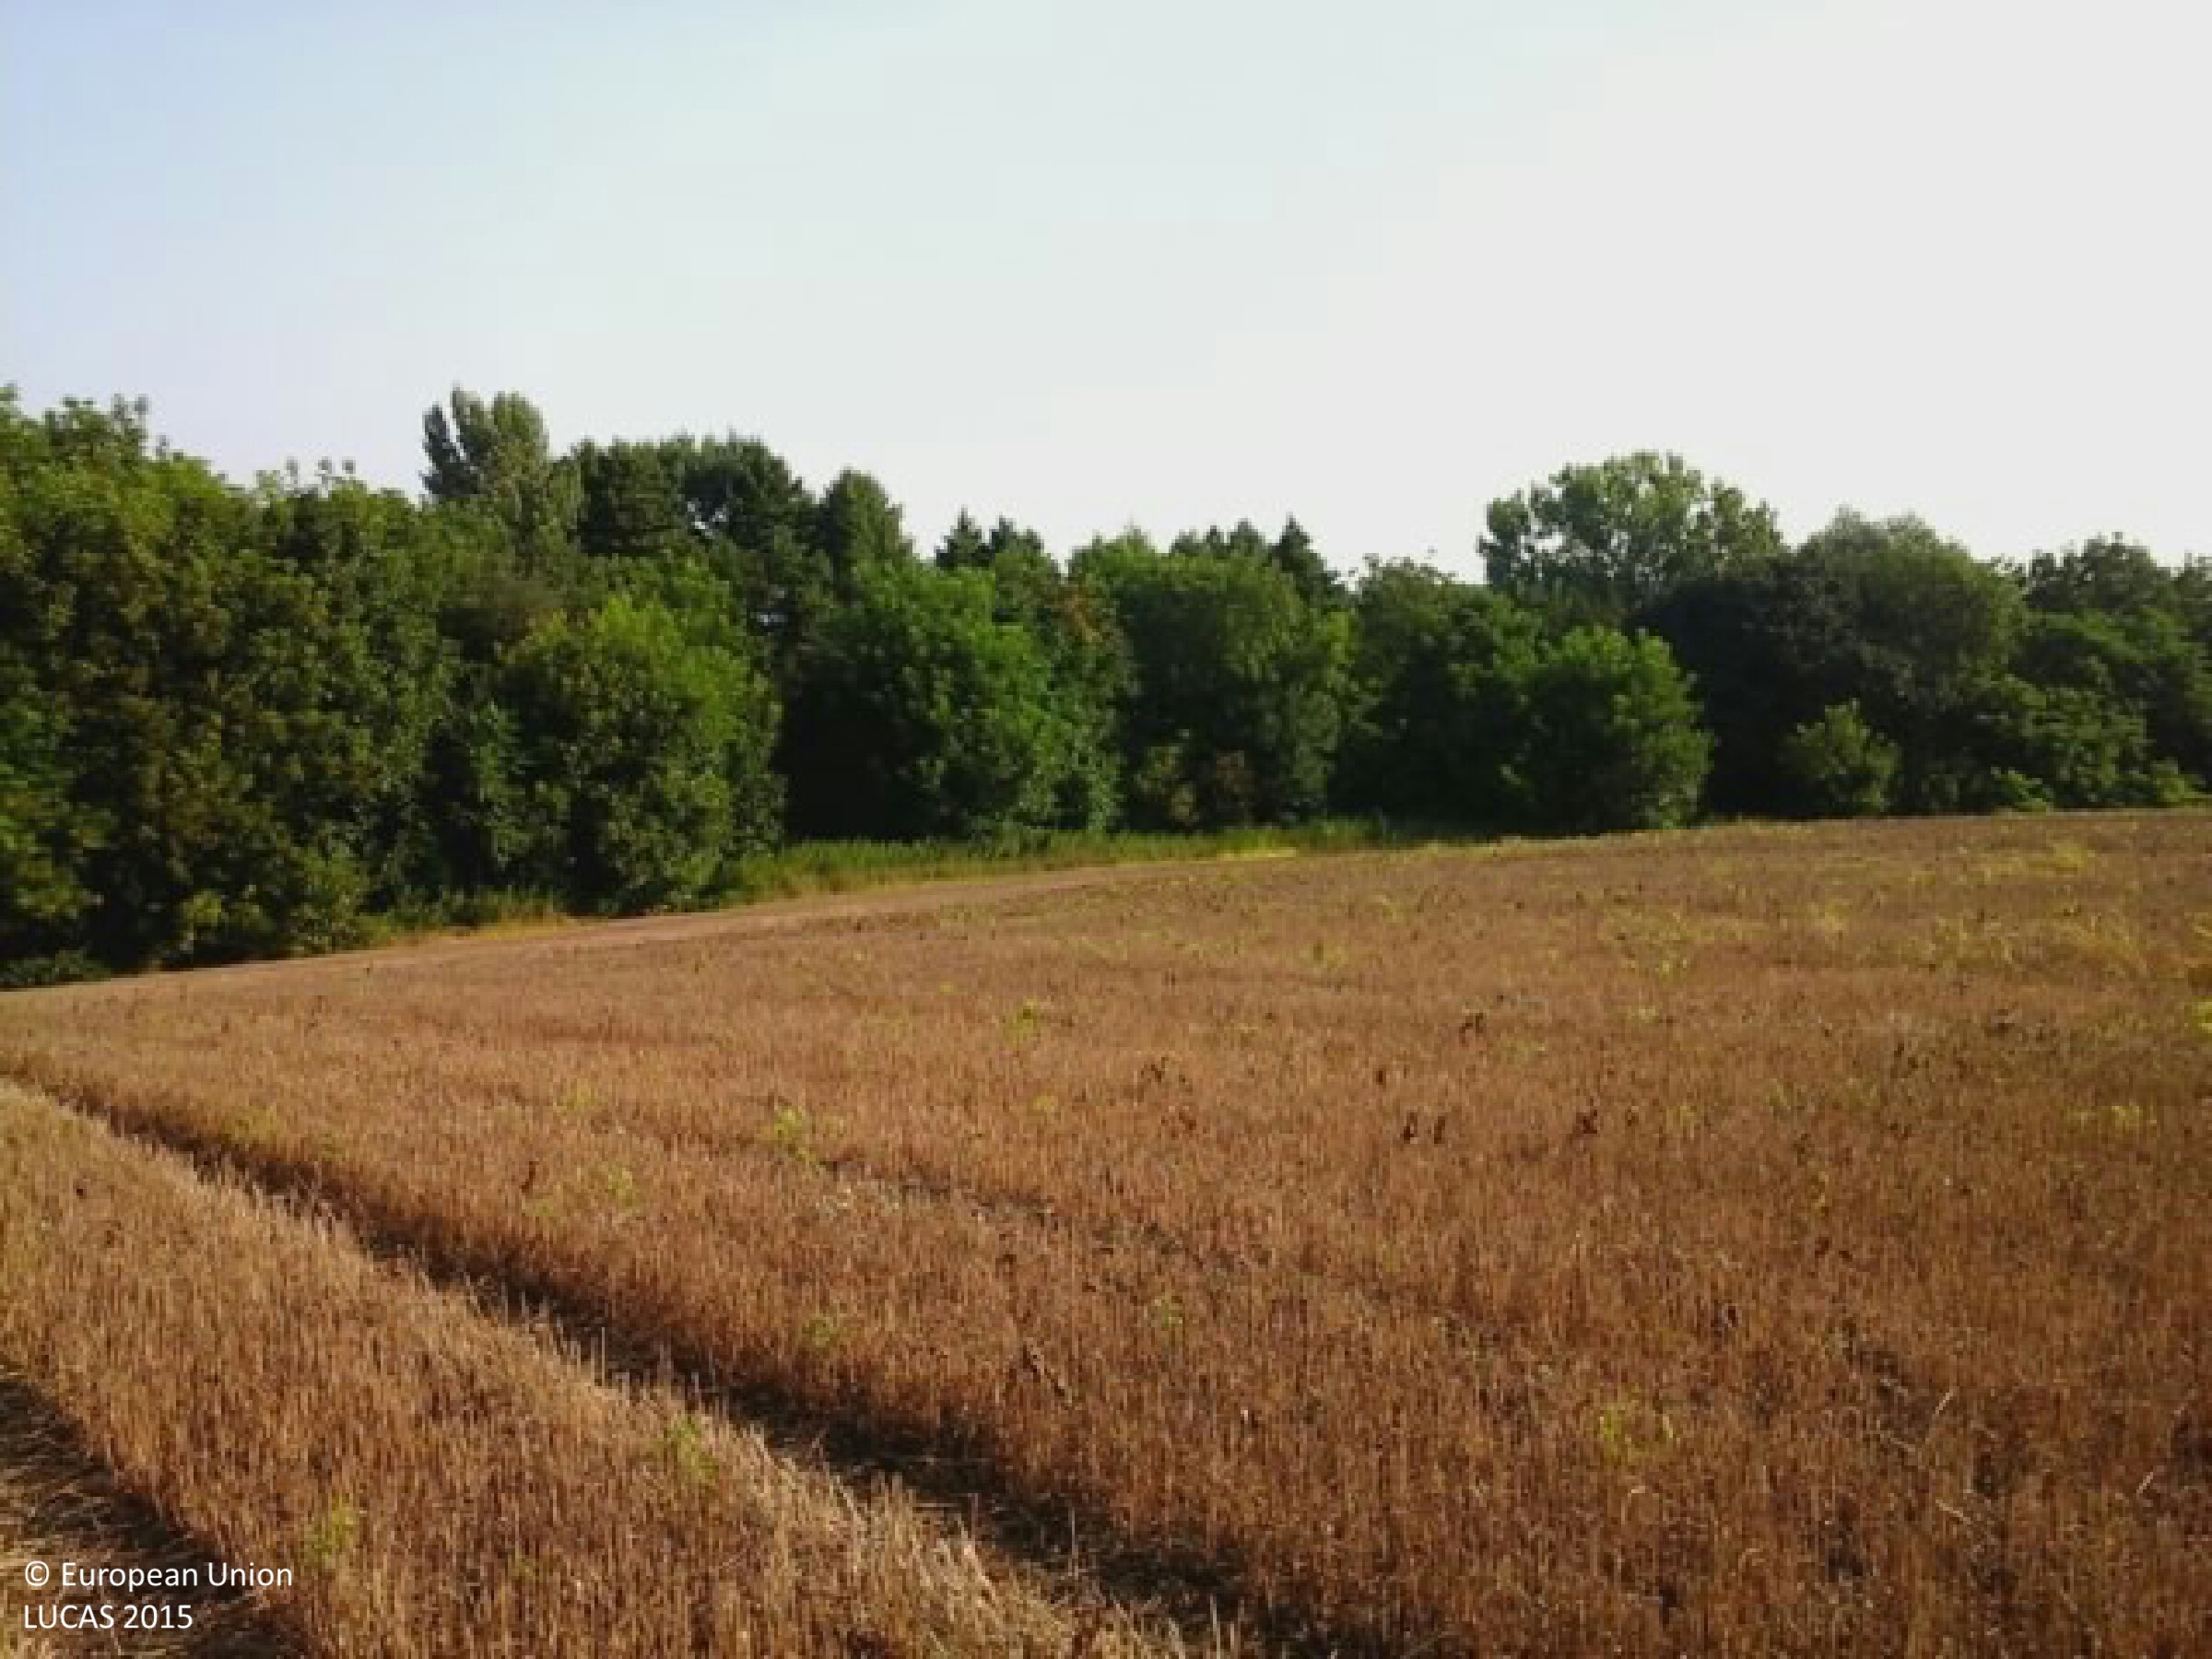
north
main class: Cropland
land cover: Common wheat
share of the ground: > 75 %
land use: Agriculture (excluding fallow land and kitchen gardens)
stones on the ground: < 10 %
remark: Harvested field
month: August
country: HU
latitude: 46.4560
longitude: 17.9098
